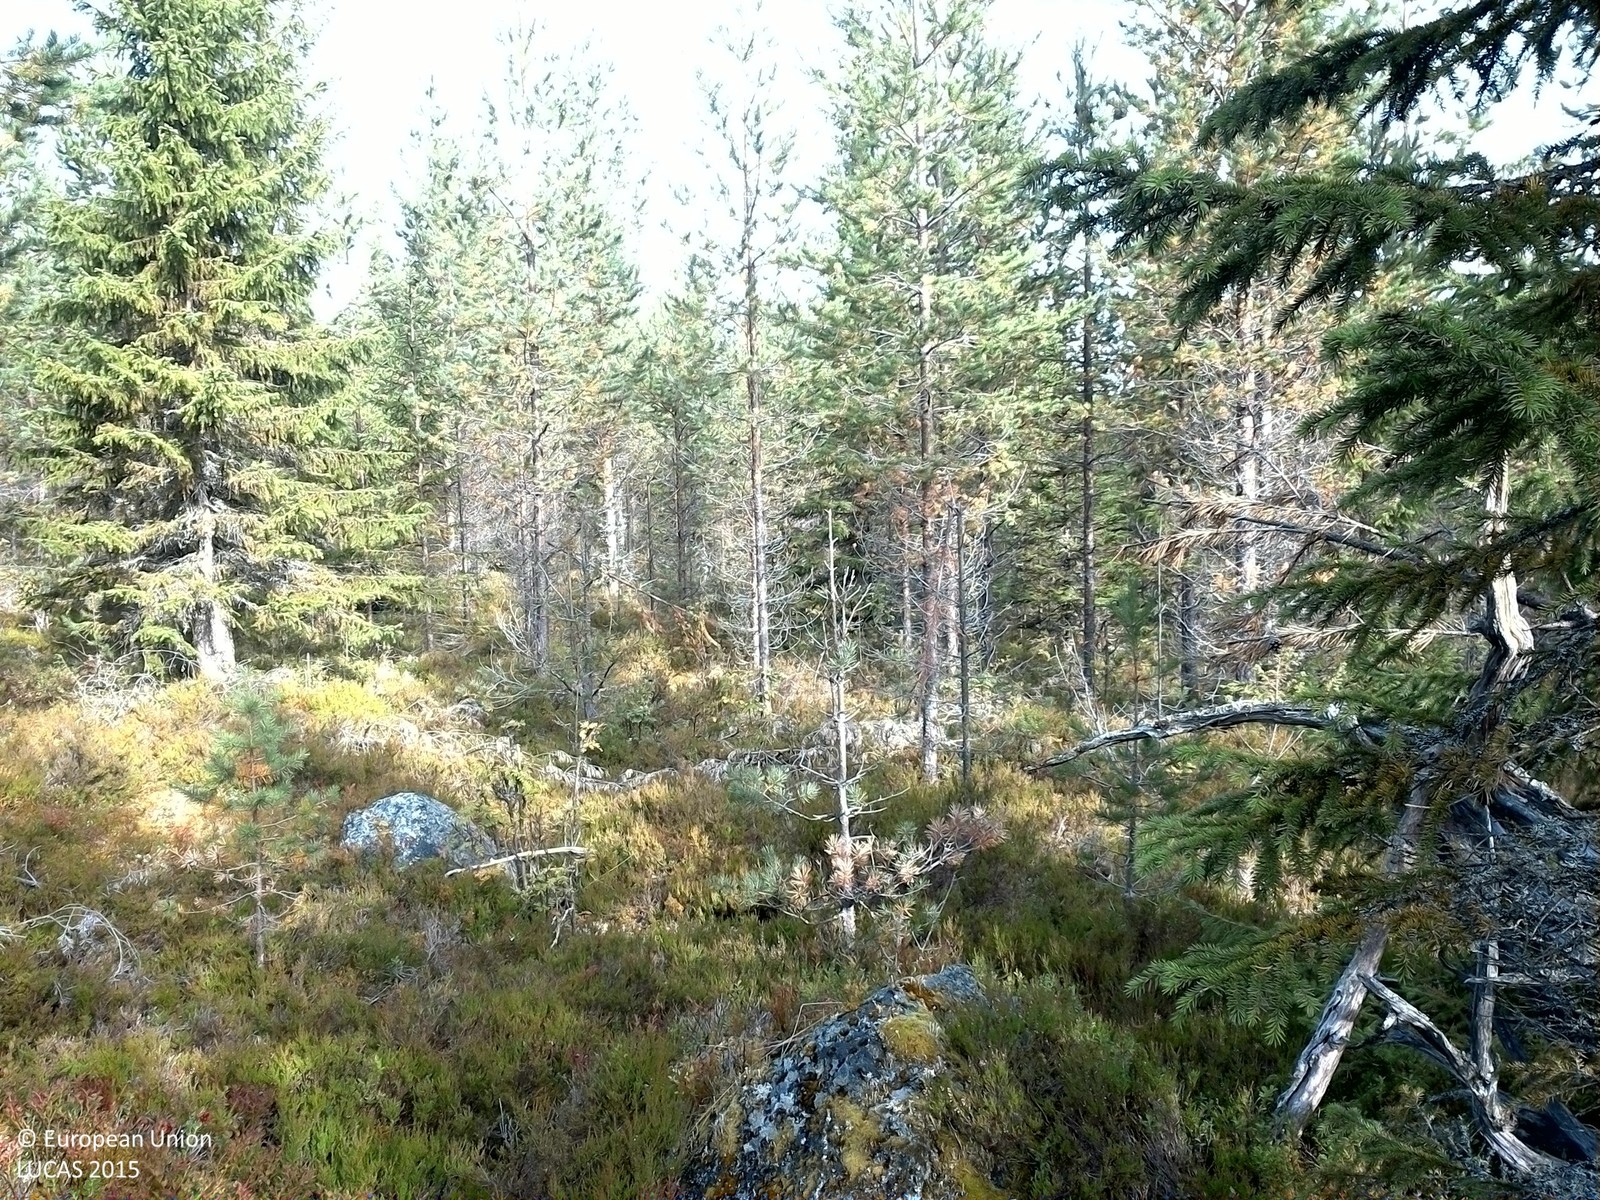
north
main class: Woodland
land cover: Pine dominated coniferous woodland
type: boreal forest
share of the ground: 25 - 50 %
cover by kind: shrubs 45 %, coniferous forest trees 35 %, lichens and mosses 15 %, broadleaved forest trees 5 %
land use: Forestry
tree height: > 5 m
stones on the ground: 10 - 25 %
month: September
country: SE
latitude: 63.9901
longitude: 16.5725
